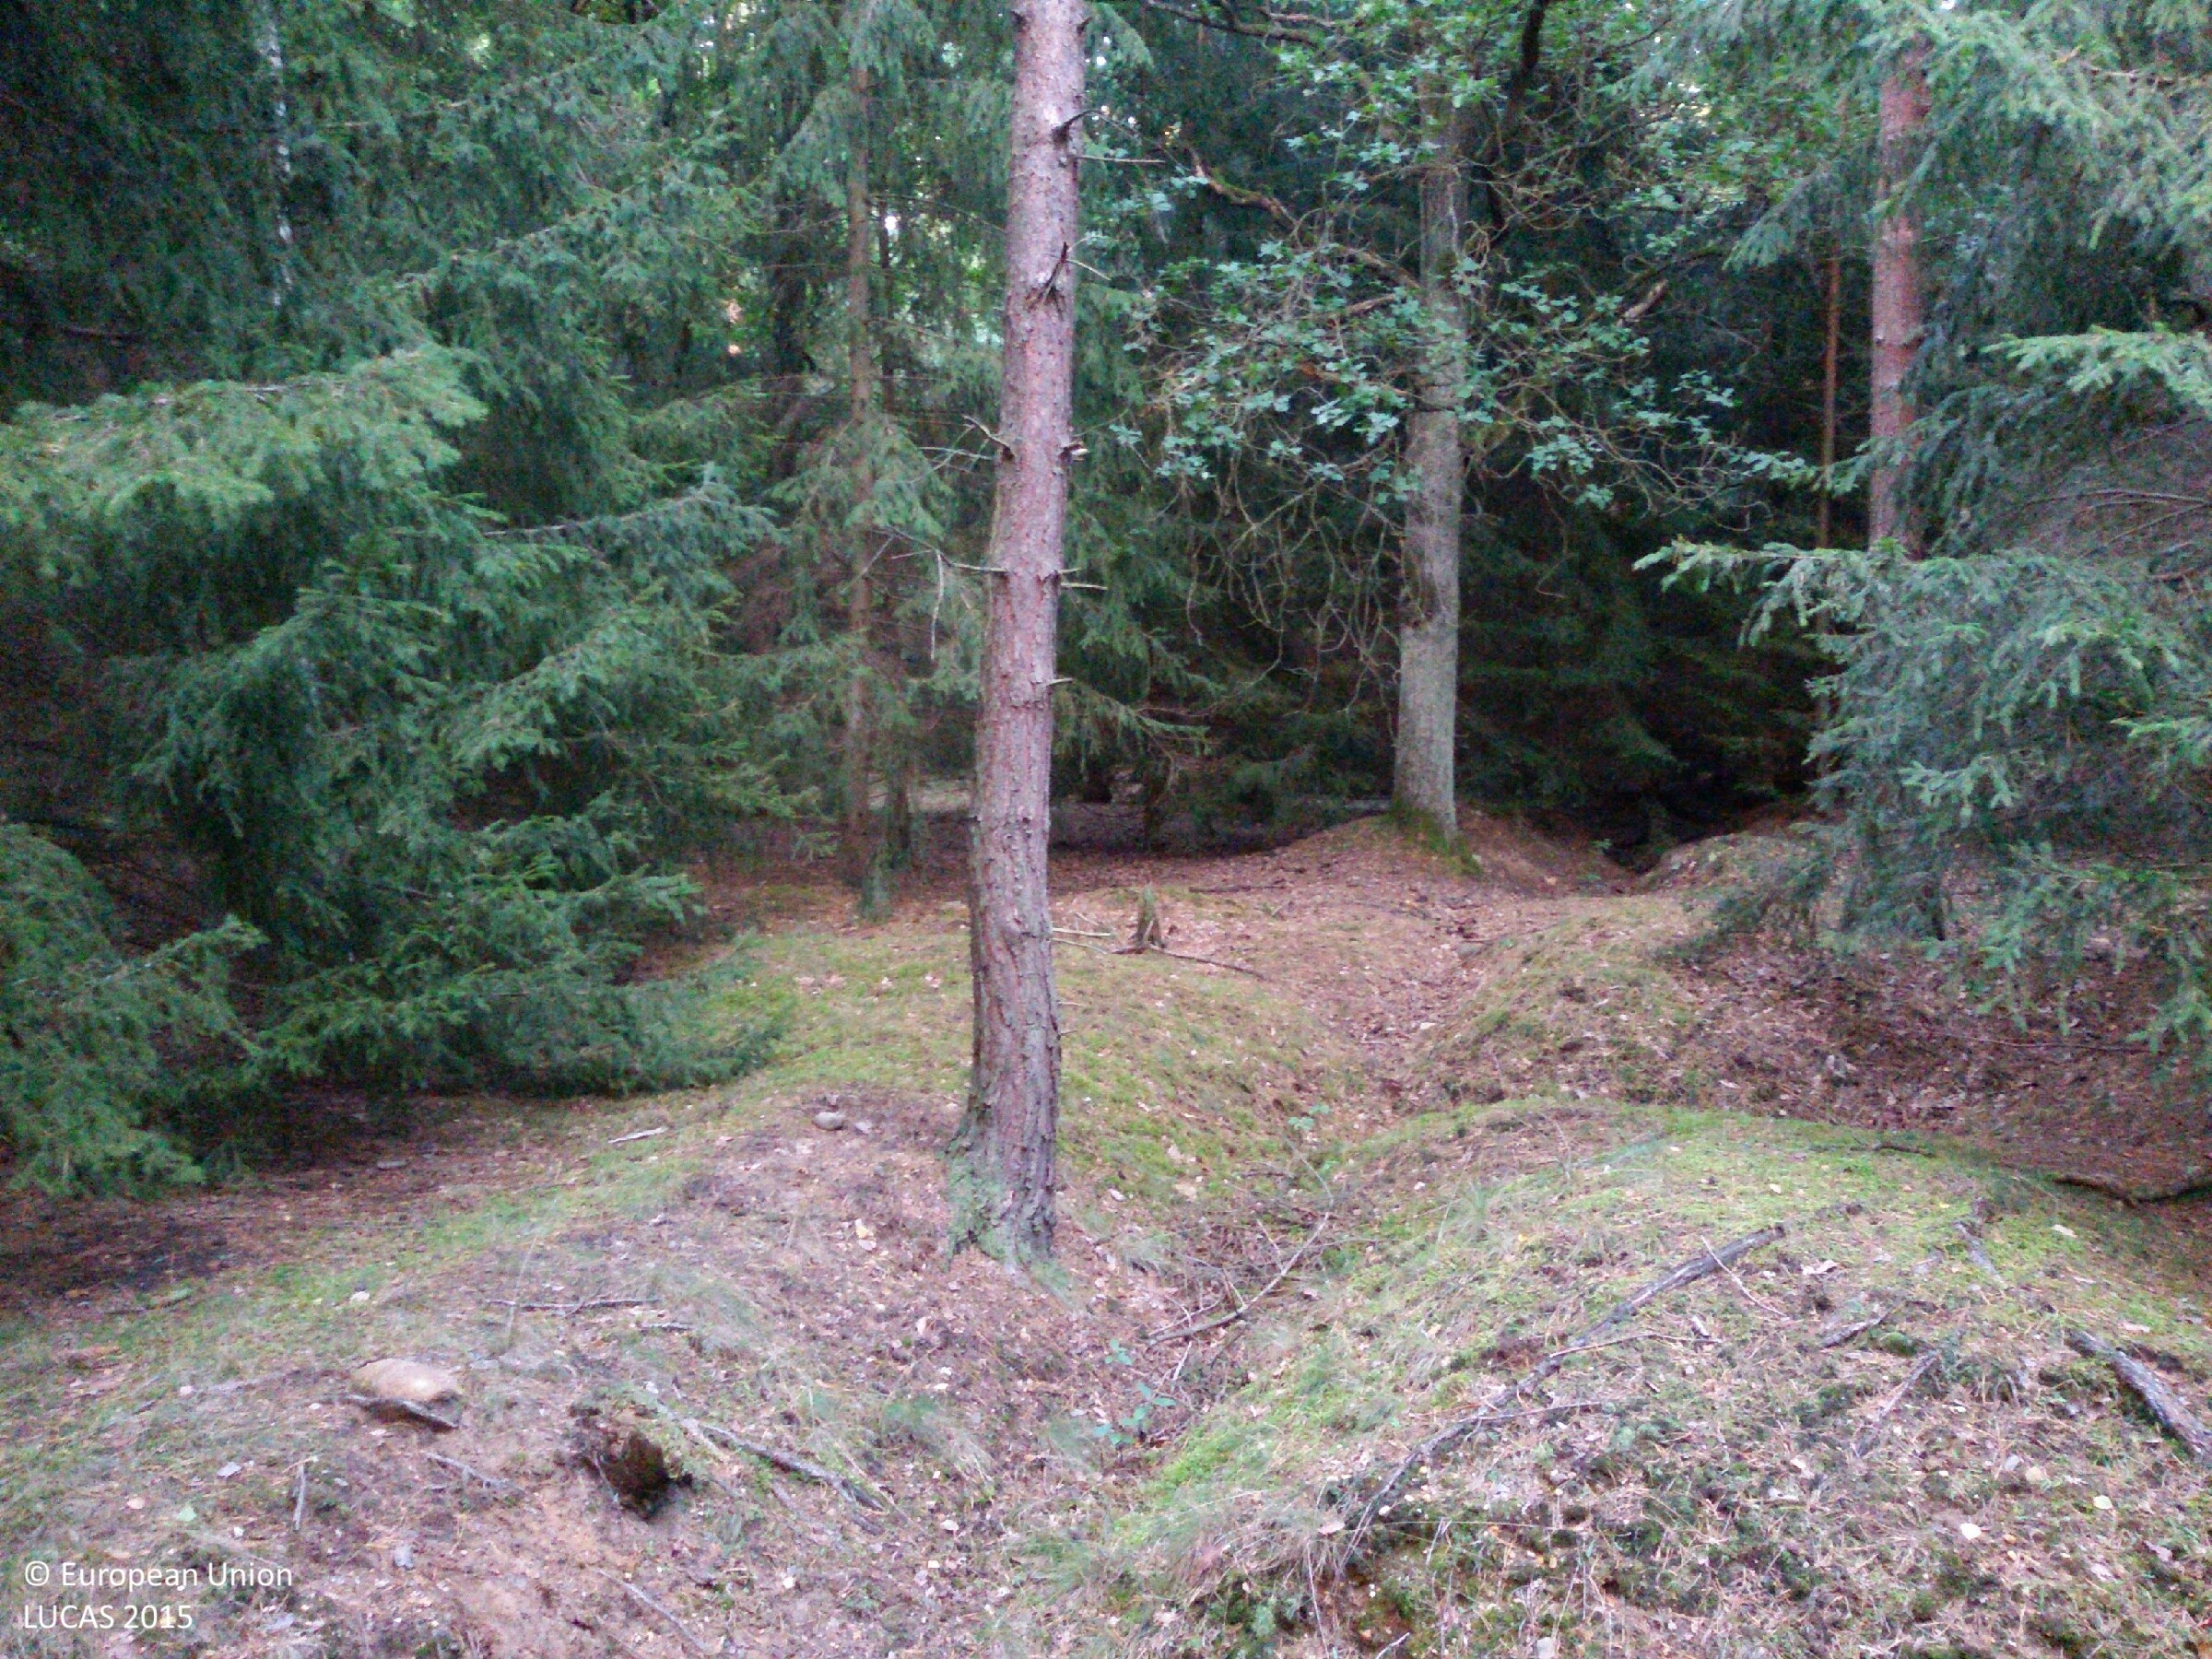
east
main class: Woodland
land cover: Pine dominated mixed woodland
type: hemiboreal forest and nemoral coniferous forest and mixed broadleaved-coniferous forest
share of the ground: > 75 %
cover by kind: coniferous forest trees 55 %, broadleaved forest trees 25 %, shrubs 10 %, herbaceous plants 5 %, lichens and mosses 5 %
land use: Forestry
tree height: > 5 m
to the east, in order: Pine dominated mixed woodland; Tracks; Pine dominated coniferous woodland
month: September
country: PL
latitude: 51.5634
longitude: 14.7194
